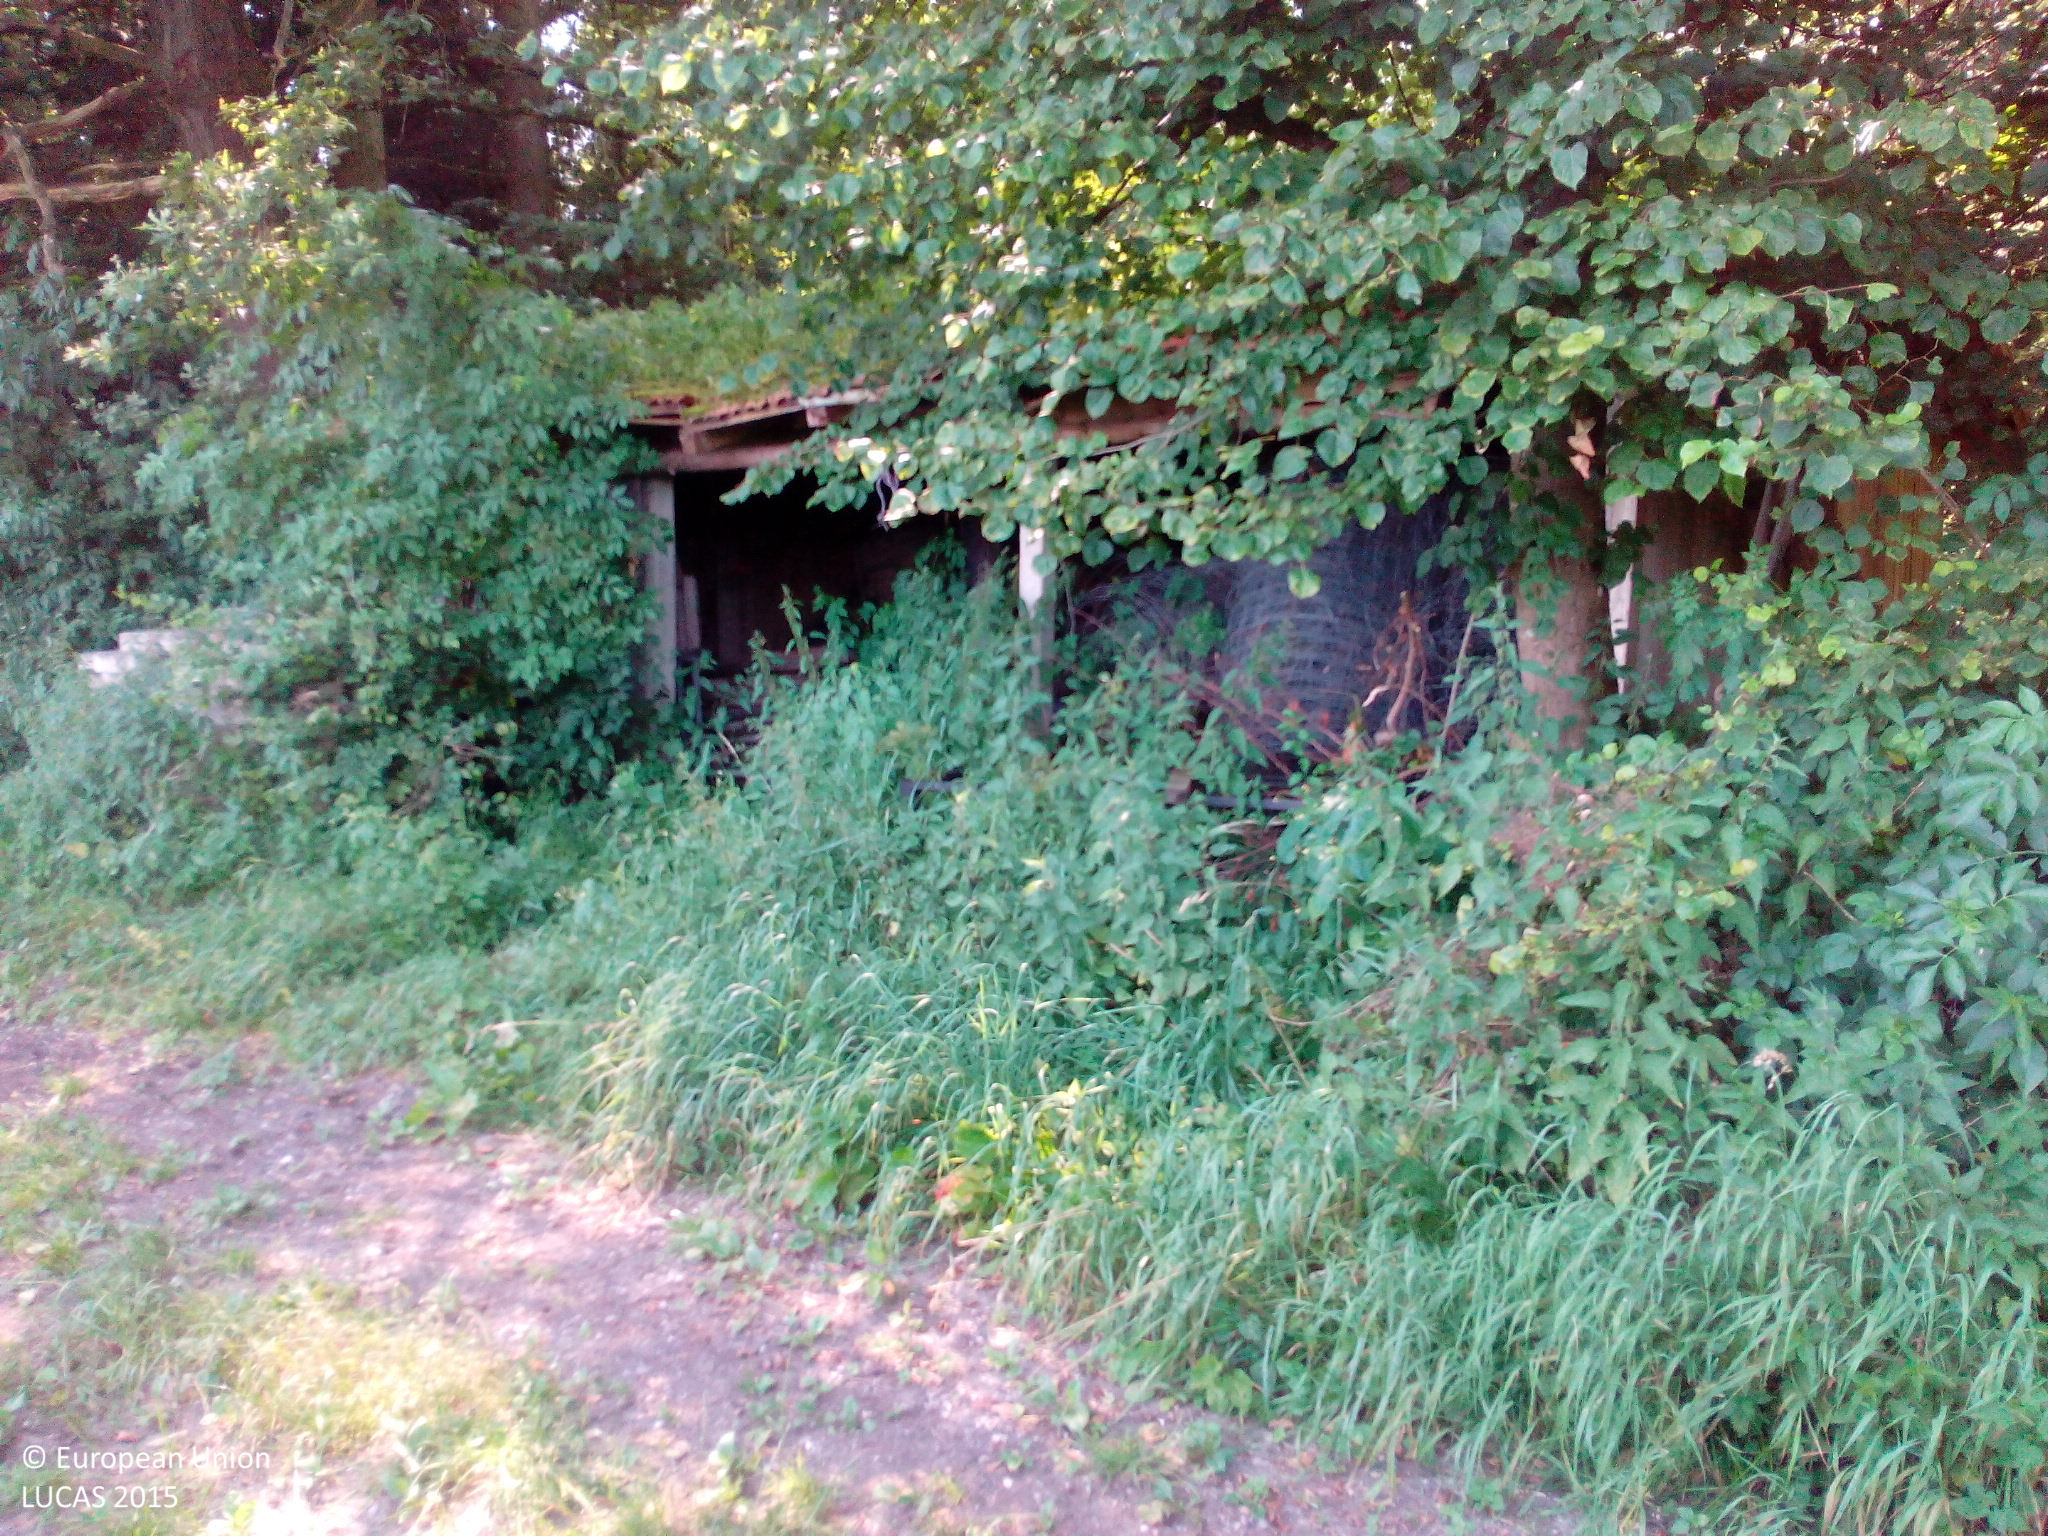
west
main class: Cropland
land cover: Maize
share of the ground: > 75 %
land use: Agriculture (excluding fallow land and kitchen gardens)
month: July
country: DE
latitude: 48.2216
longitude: 12.8930
